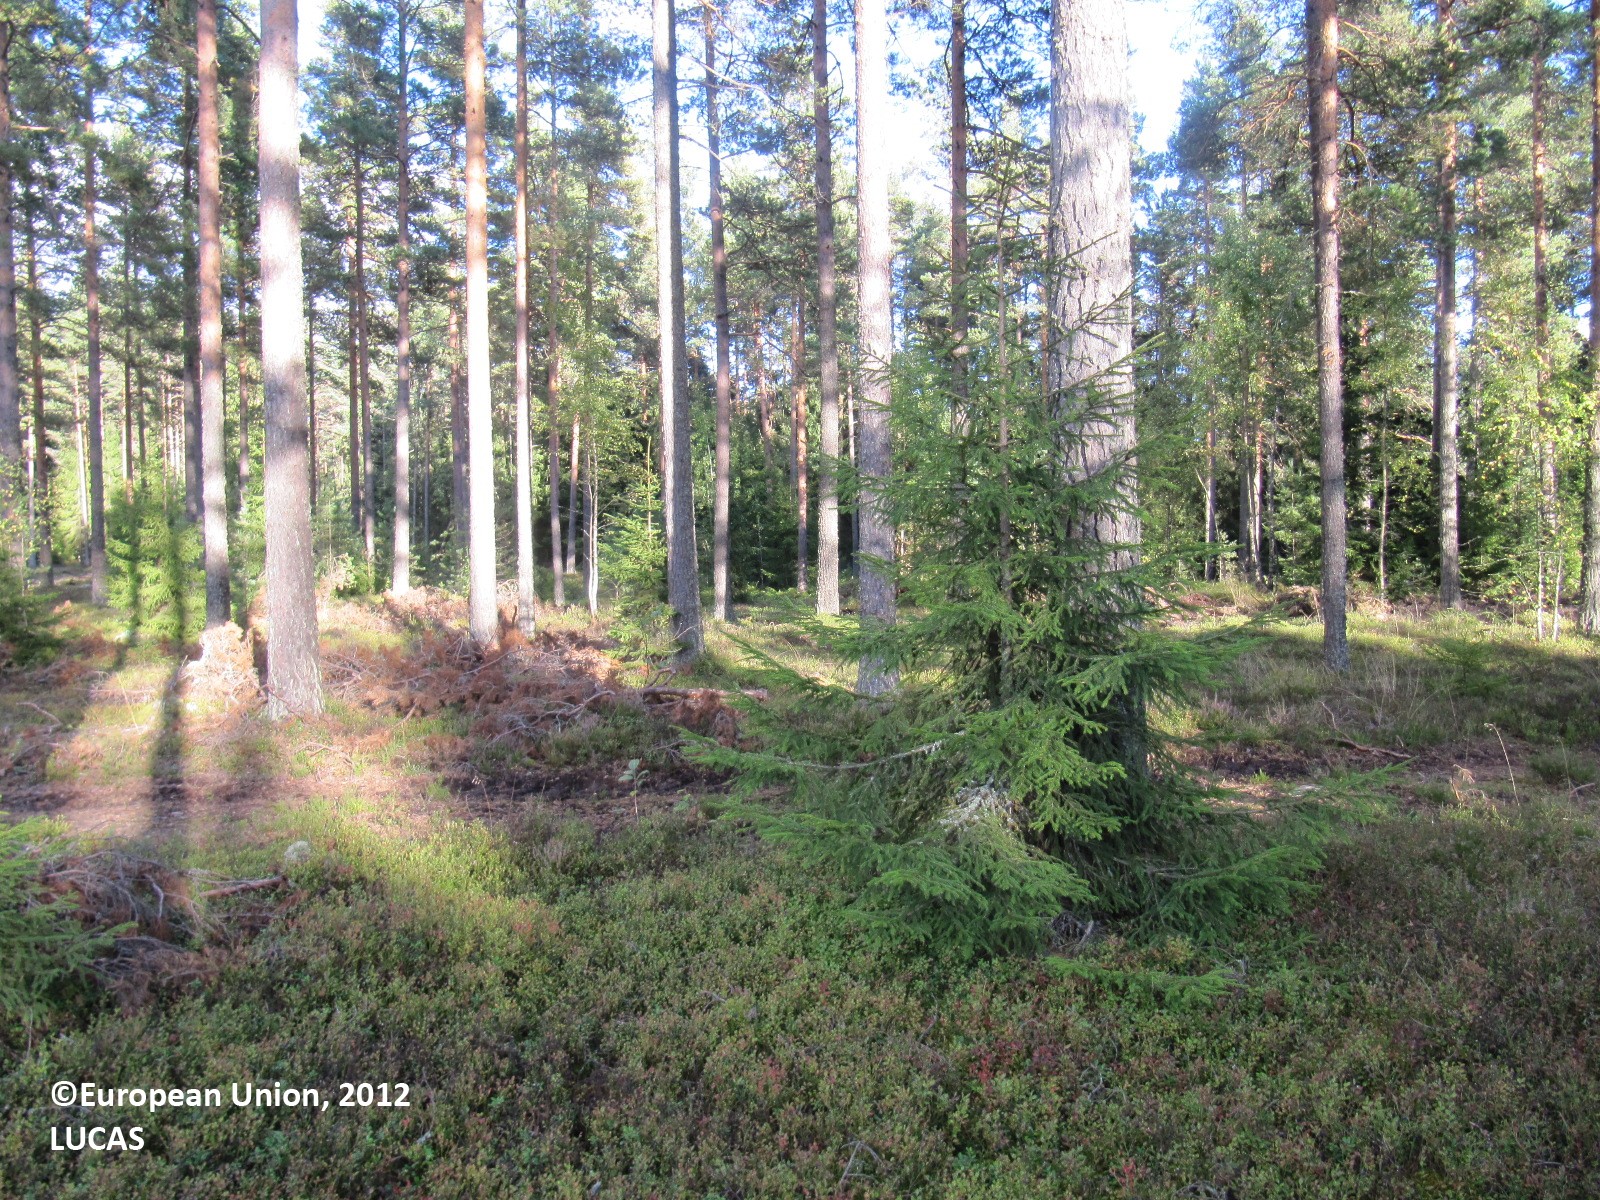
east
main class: Woodland
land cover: Pine dominated mixed woodland
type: boreal forest
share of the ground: 25 - 50 %
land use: Forestry
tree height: > 5 m
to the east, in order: Pine dominated mixed woodland; Fences; Pine dominated mixed woodland; Fences; Spruce dominated mixed woodland; Tracks; Shrubland with sparse tree cover
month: September
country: FI
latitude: 60.0899
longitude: 23.7399
